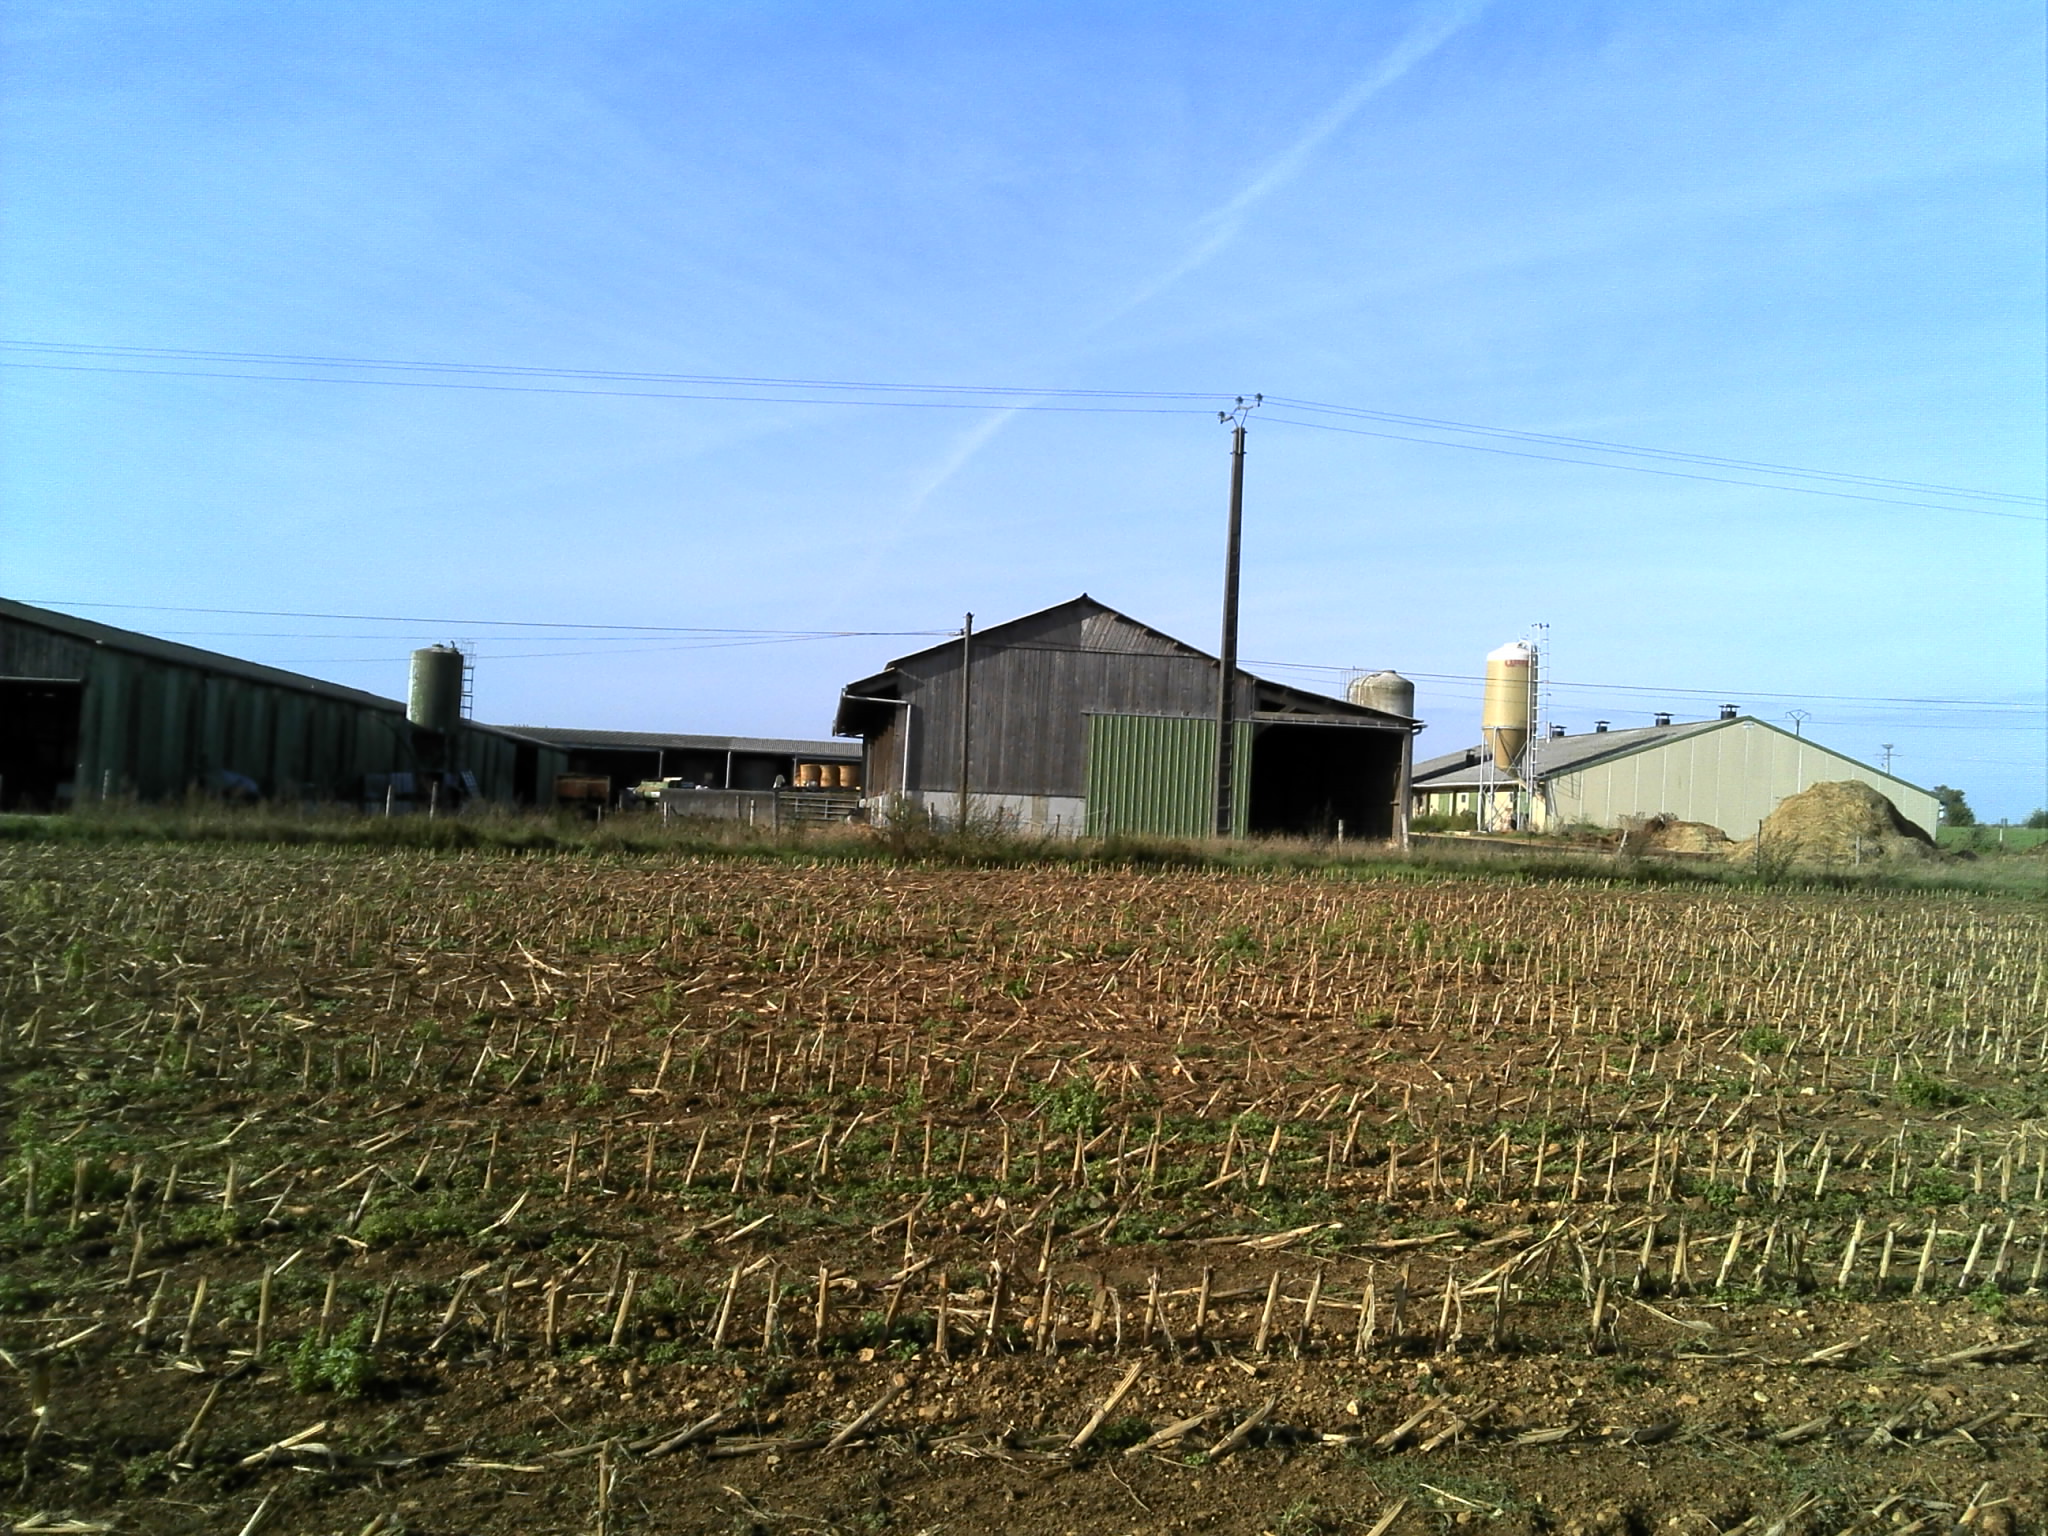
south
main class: Cropland
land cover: Maize
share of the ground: < 10 %
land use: Agriculture (excluding fallow land and kitchen gardens)
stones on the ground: 10 - 25 %
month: September
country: FR
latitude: 48.0898
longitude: 0.5654
